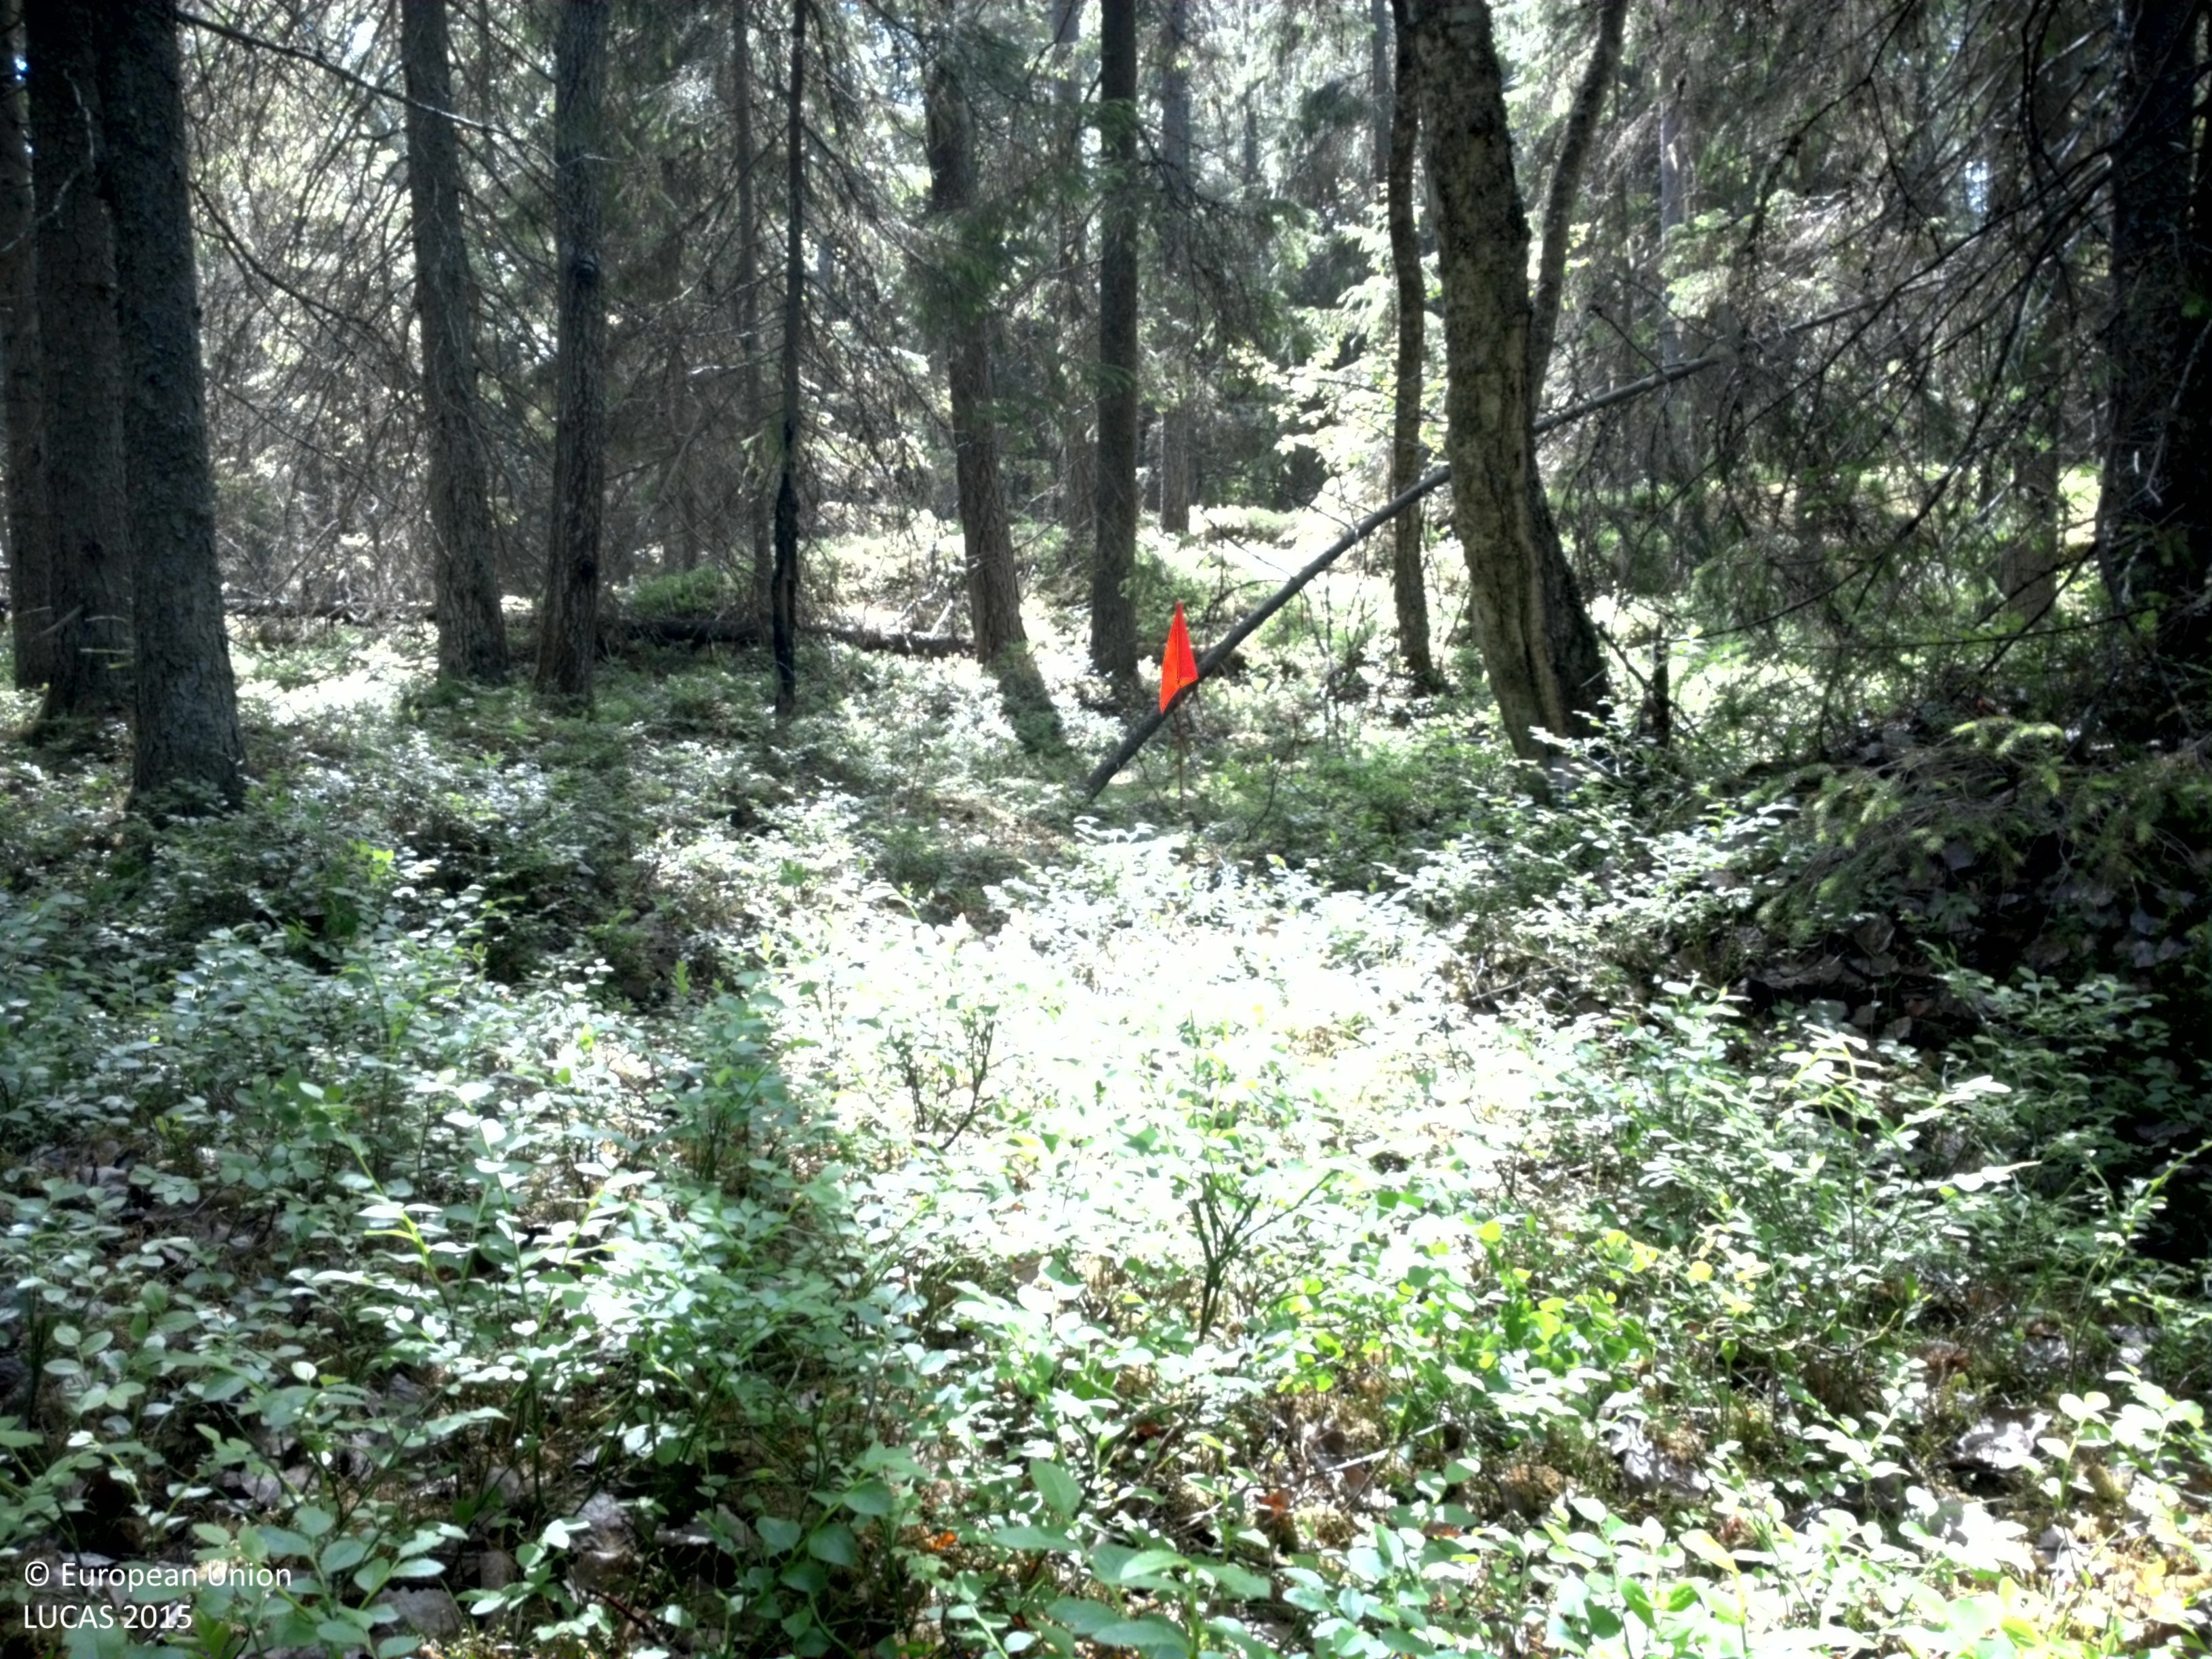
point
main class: Woodland
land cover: Spruce dominated coniferous woodland
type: boreal forest
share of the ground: > 75 %
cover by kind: coniferous forest trees 70 %, broadleaved forest trees 10 %, herbaceous plants 10 %, lichens and mosses 10 %
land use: Forestry
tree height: > 5 m
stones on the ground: < 10 %
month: June
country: SE
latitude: 60.0783
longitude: 18.6428
